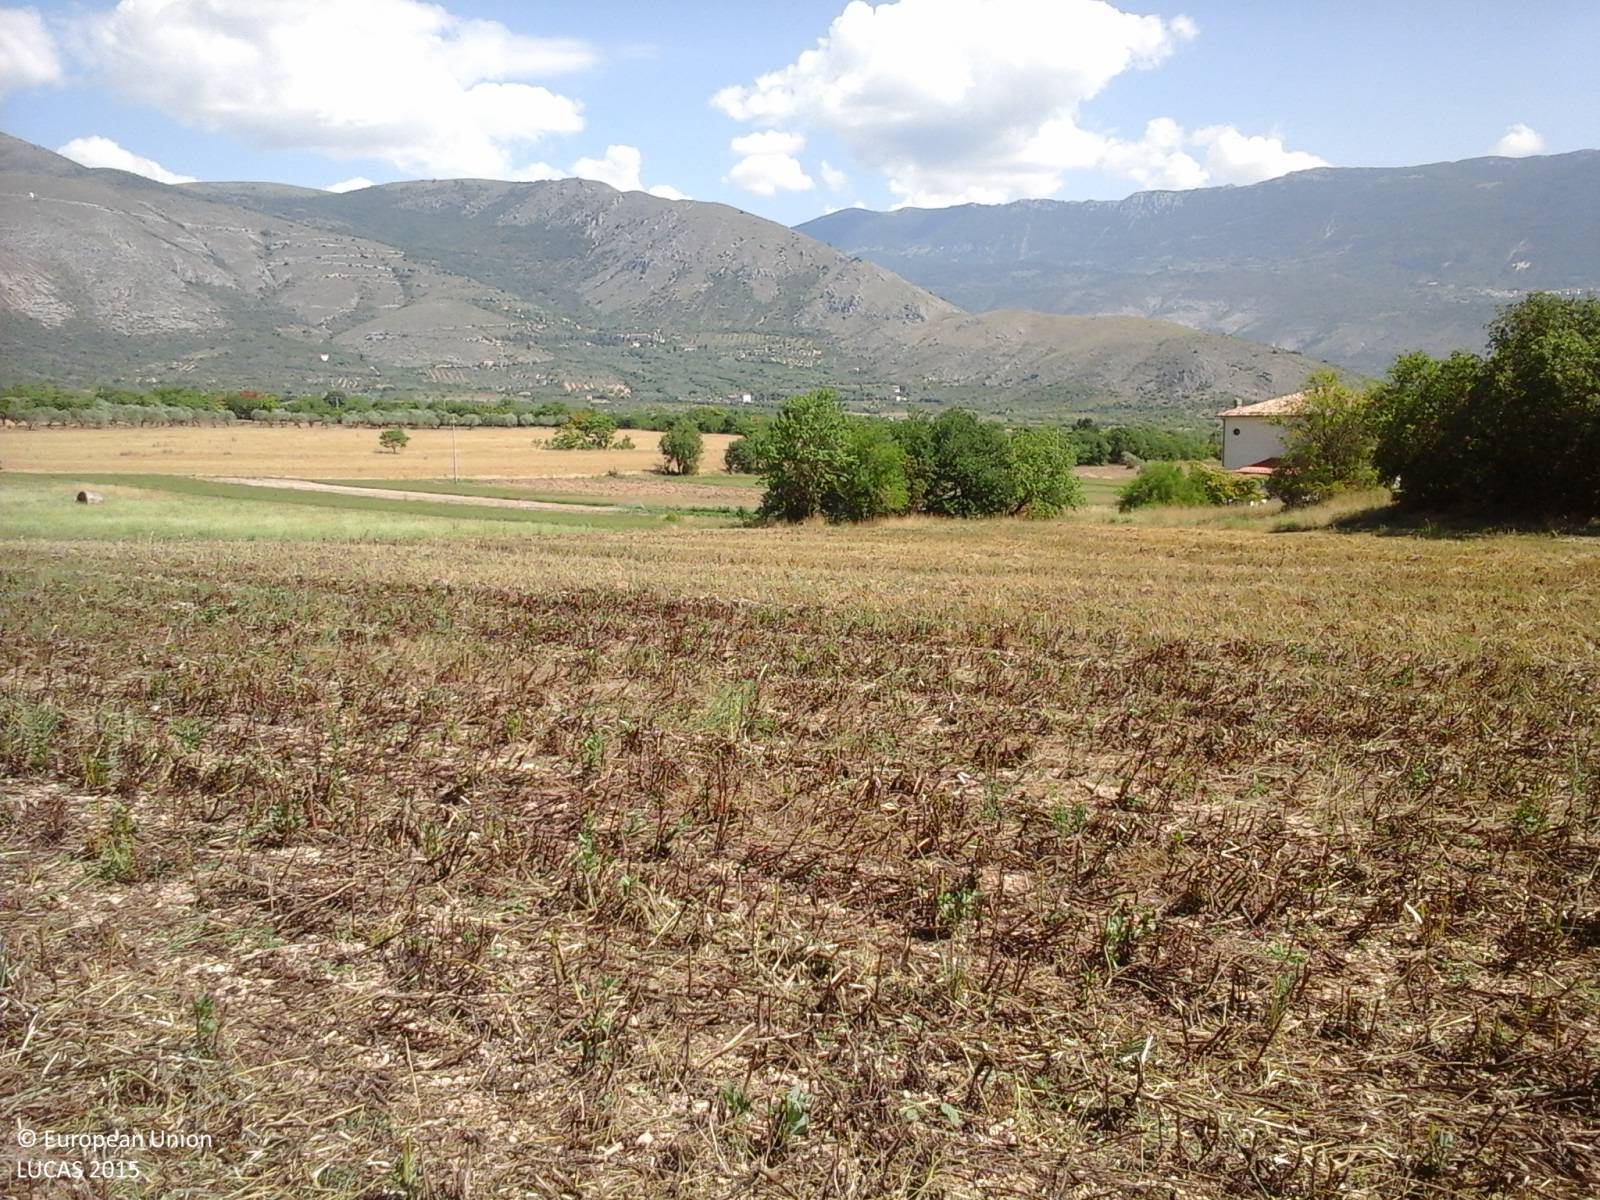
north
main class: Cropland
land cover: Lucerne
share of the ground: > 75 %
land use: Agriculture (excluding fallow land and kitchen gardens)
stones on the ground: 10 - 25 %
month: June
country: IT
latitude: 42.2778
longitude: 13.7349
